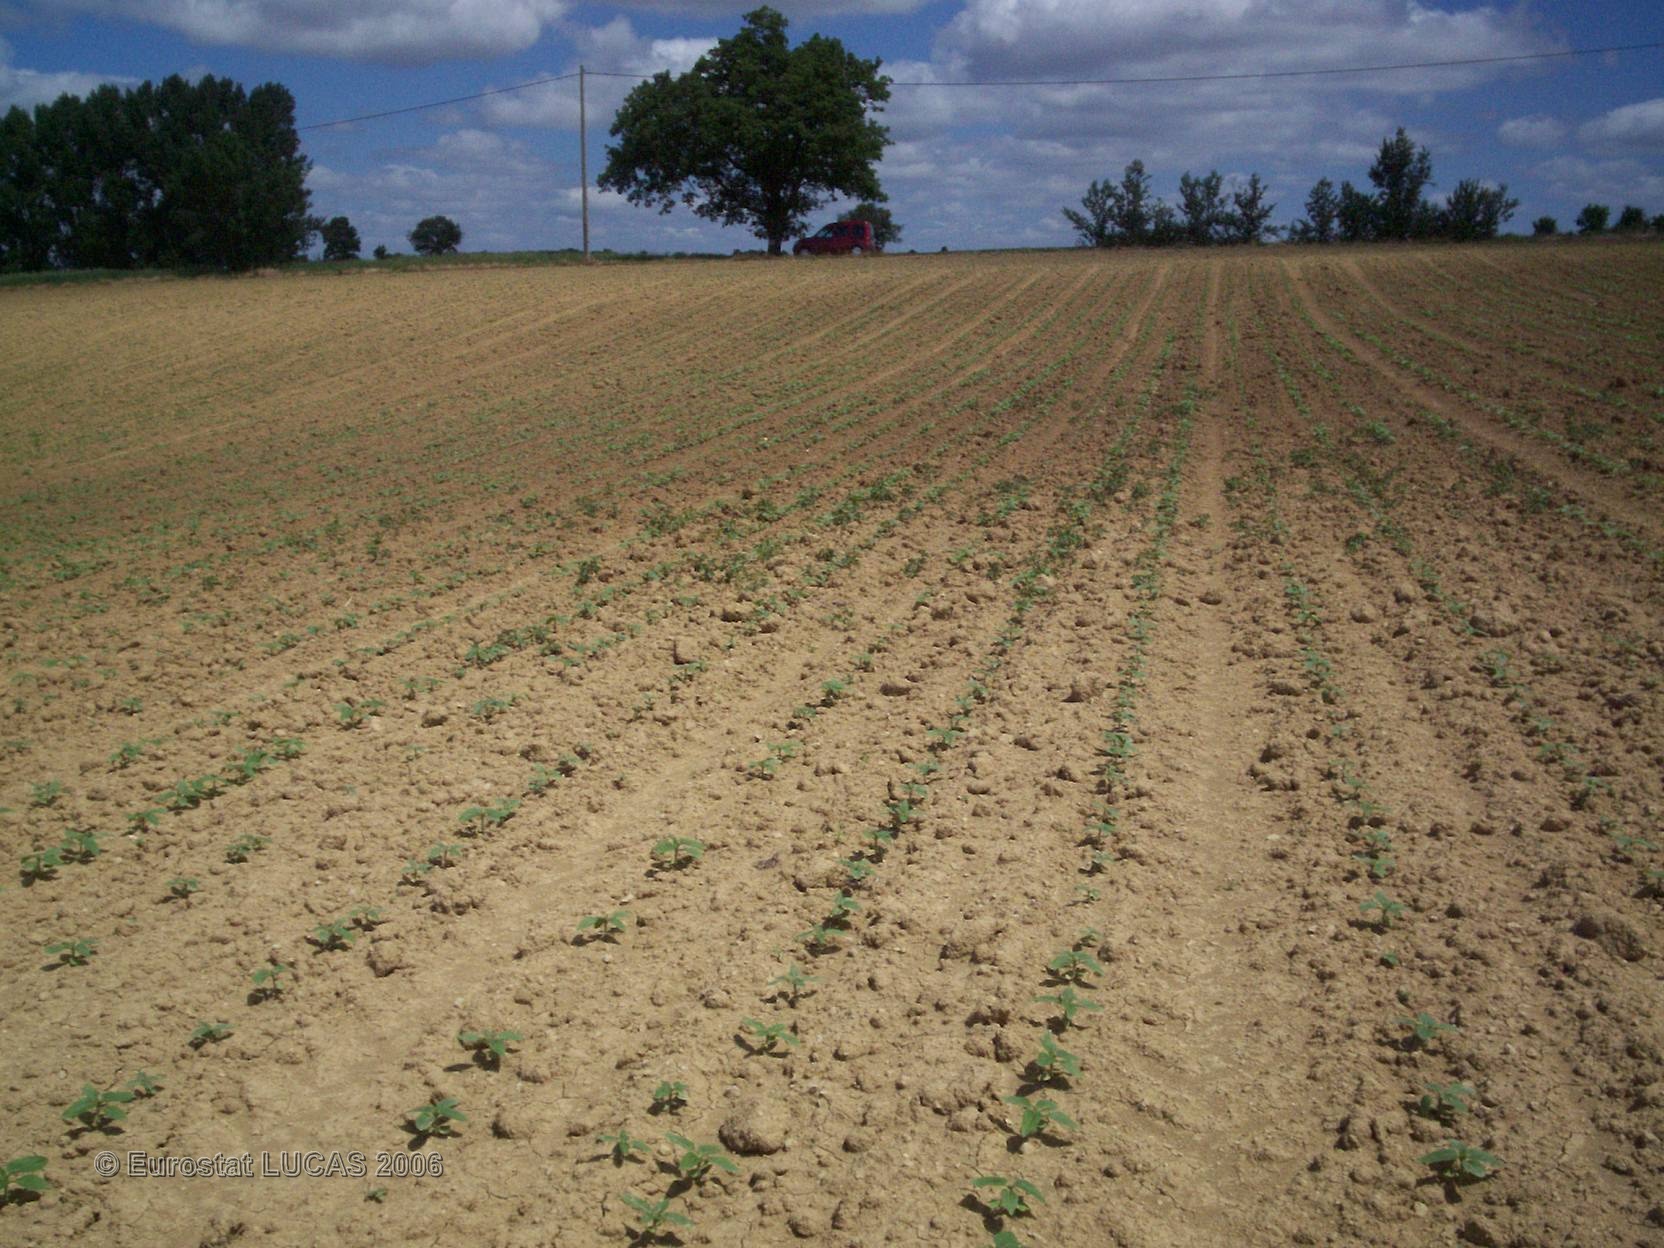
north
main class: Cropland
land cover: Soya
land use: Agriculture (excluding fallow land and kitchen gardens)
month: May
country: FR
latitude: 43.6650
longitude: 0.9592
